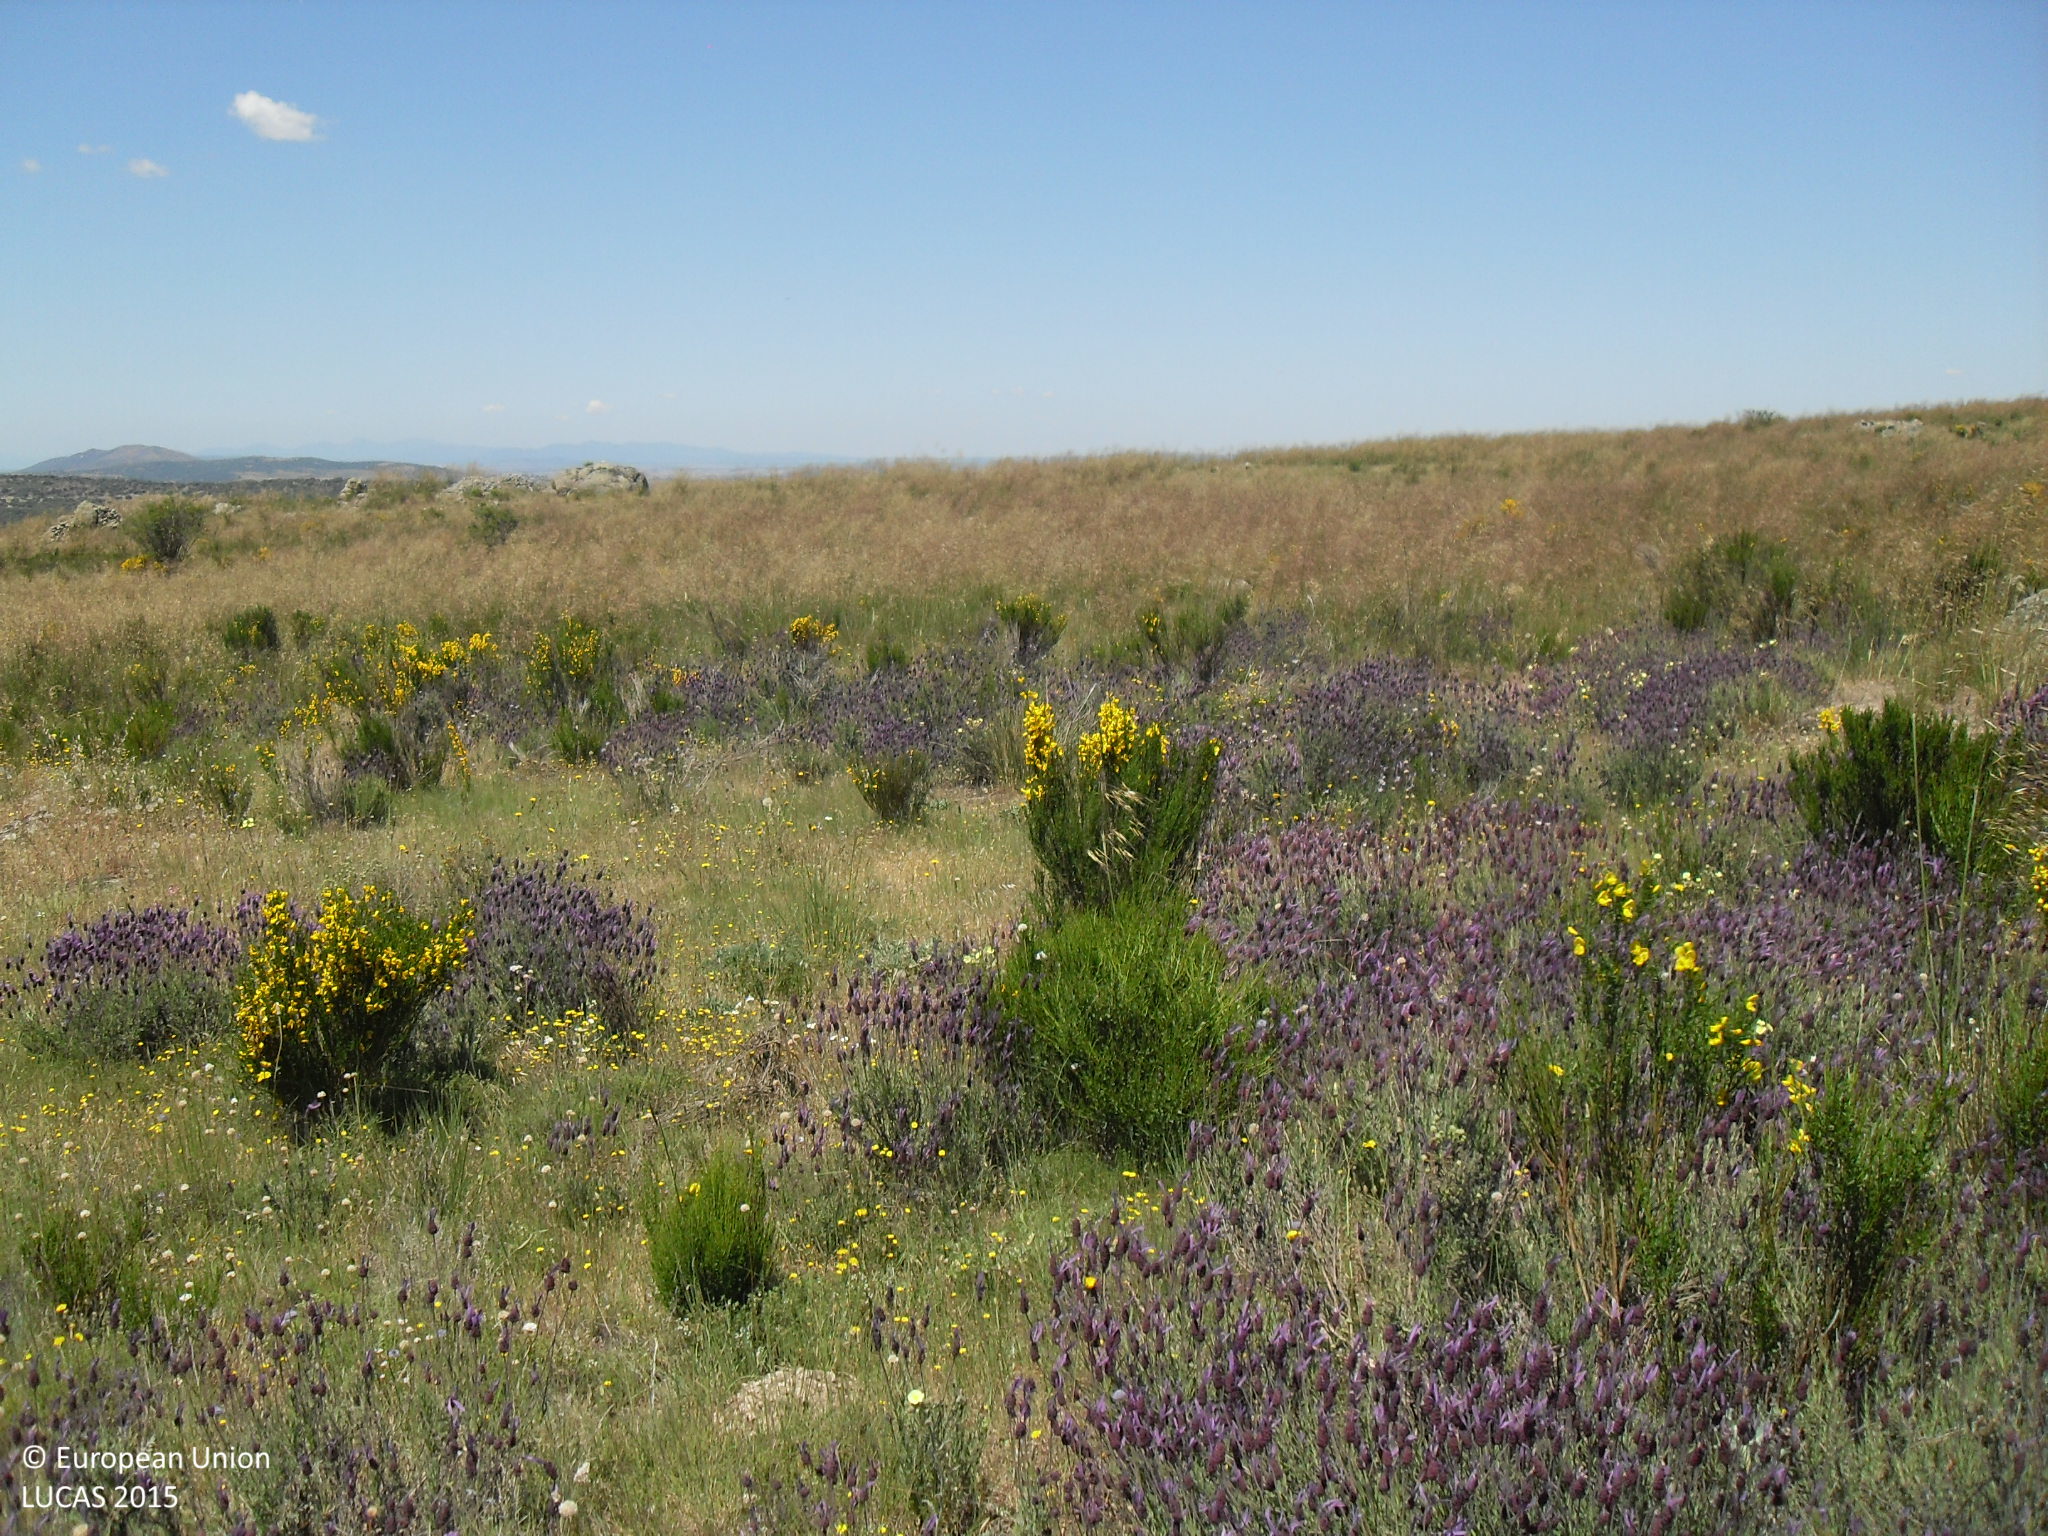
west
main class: Grassland
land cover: Grassland without tree/shrub cover
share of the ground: > 75 %
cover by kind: herbaceous plants 100 %
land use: Agriculture (excluding fallow land and kitchen gardens)
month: June
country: ES
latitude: 40.5887
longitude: -5.2708
